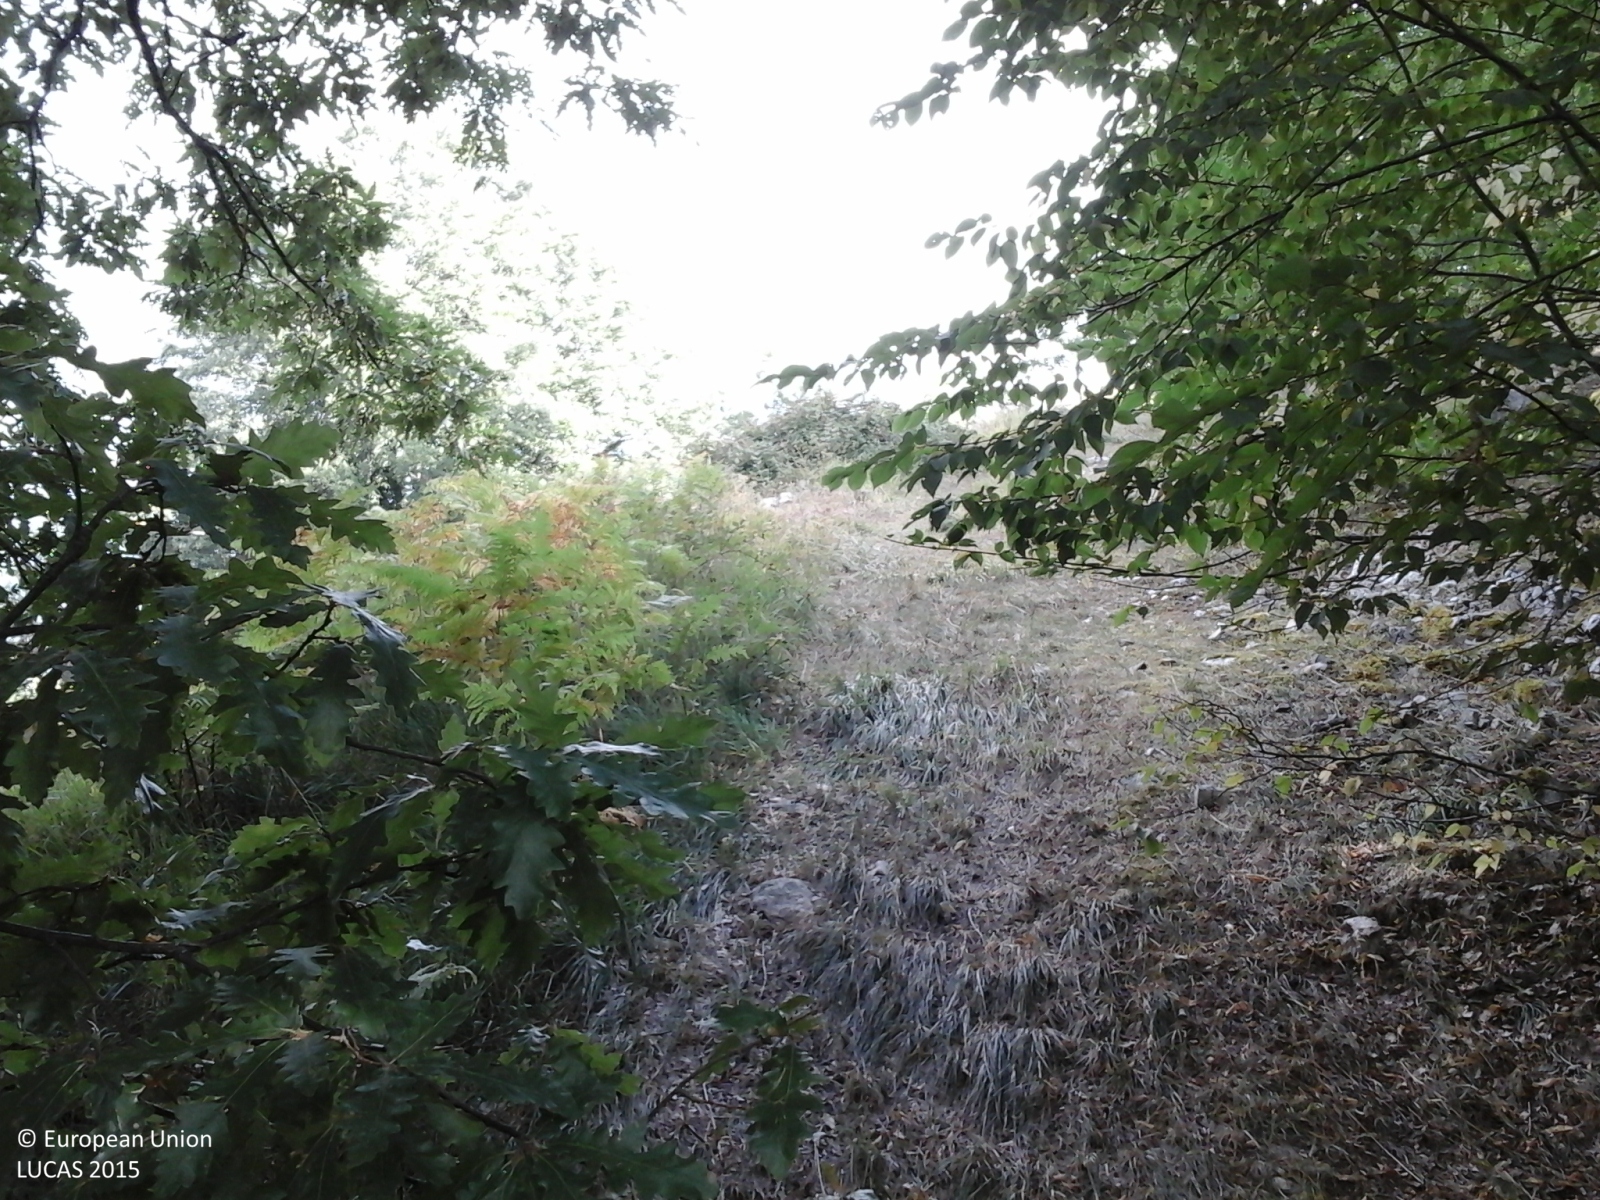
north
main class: Woodland
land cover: Broadleaved woodland
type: thermophilous deciduous forest
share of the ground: > 75 %
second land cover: Grassland without tree/shrub cover
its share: > 75 %
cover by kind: broadleaved forest trees 80 %, herbaceous plants 15 %, shrubs 5 %
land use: Forestry
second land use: Agriculture (excluding fallow land and kitchen gardens)
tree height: > 5 m
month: September
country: IT
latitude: 41.6604
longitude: 14.2483
